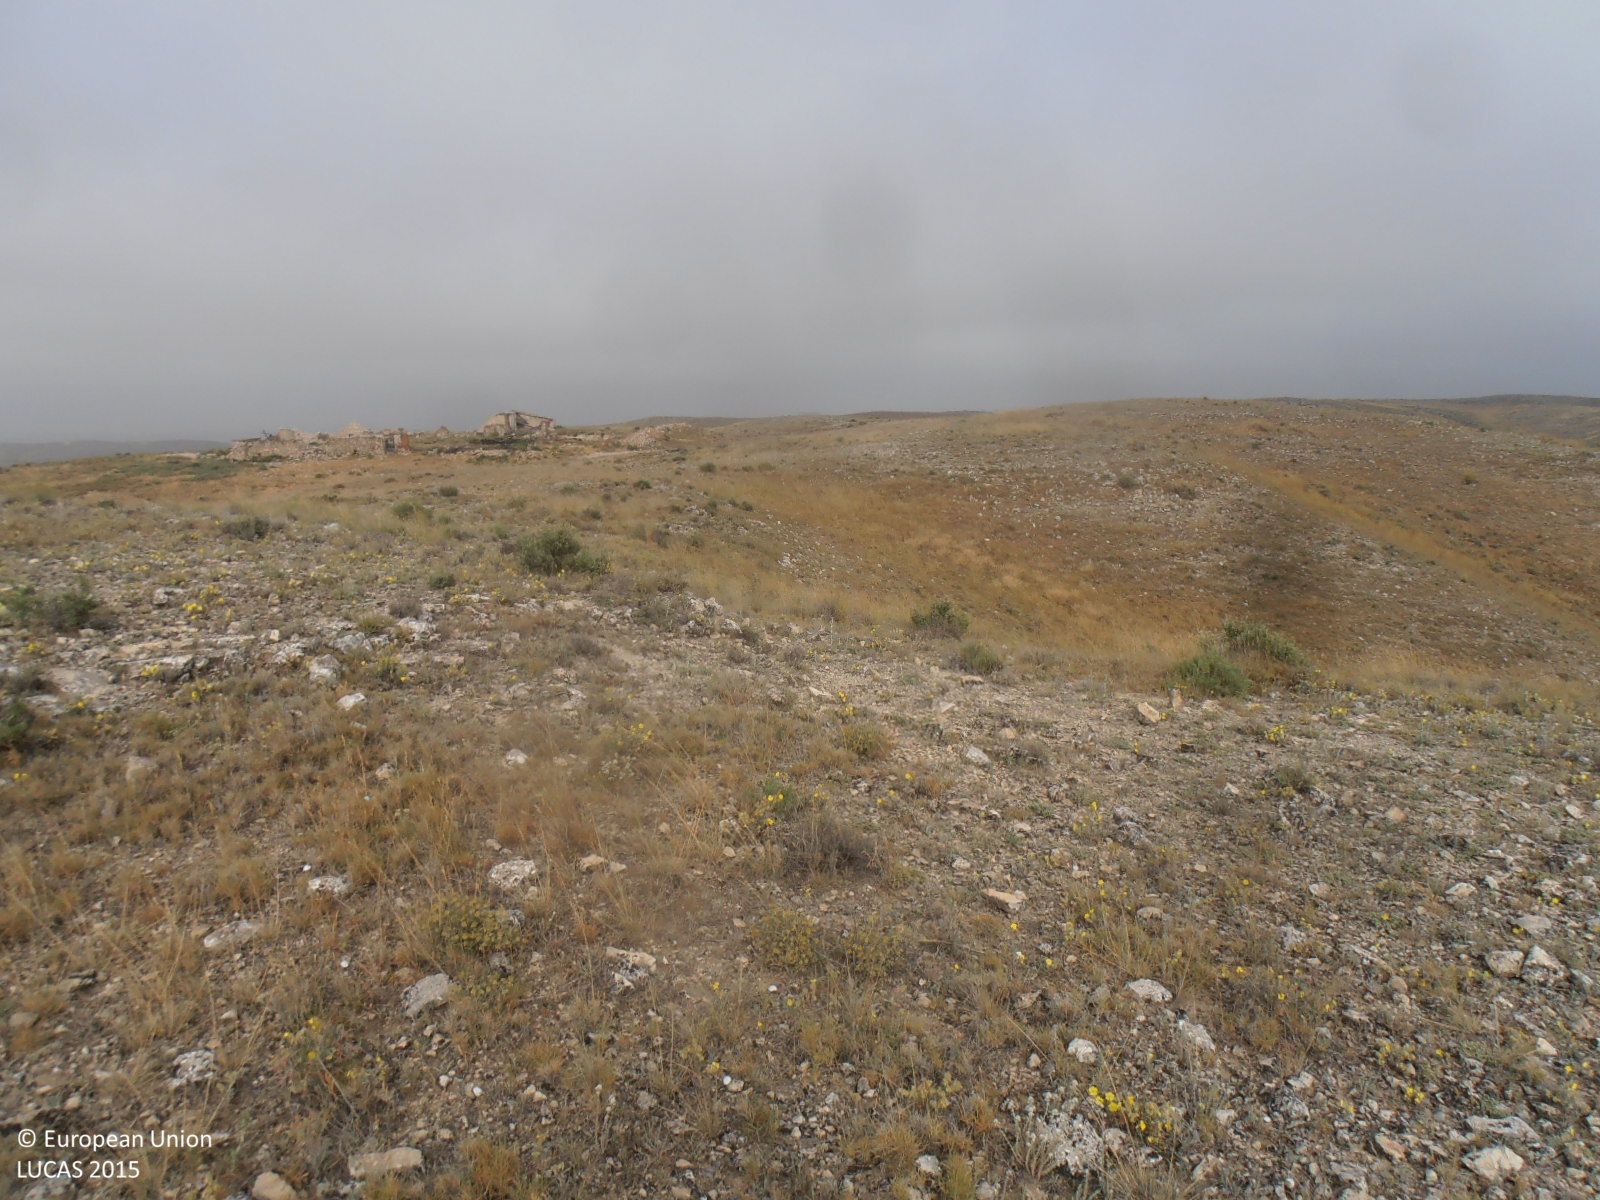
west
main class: Shrubland
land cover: Shrubland without tree cover
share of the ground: > 75 %
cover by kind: shrubs 60 %, herbaceous plants 30 %, consolidated bare surface 10 %
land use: Semi-natural and natural areas not in use
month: June
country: ES
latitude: 41.6247
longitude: -1.2468
